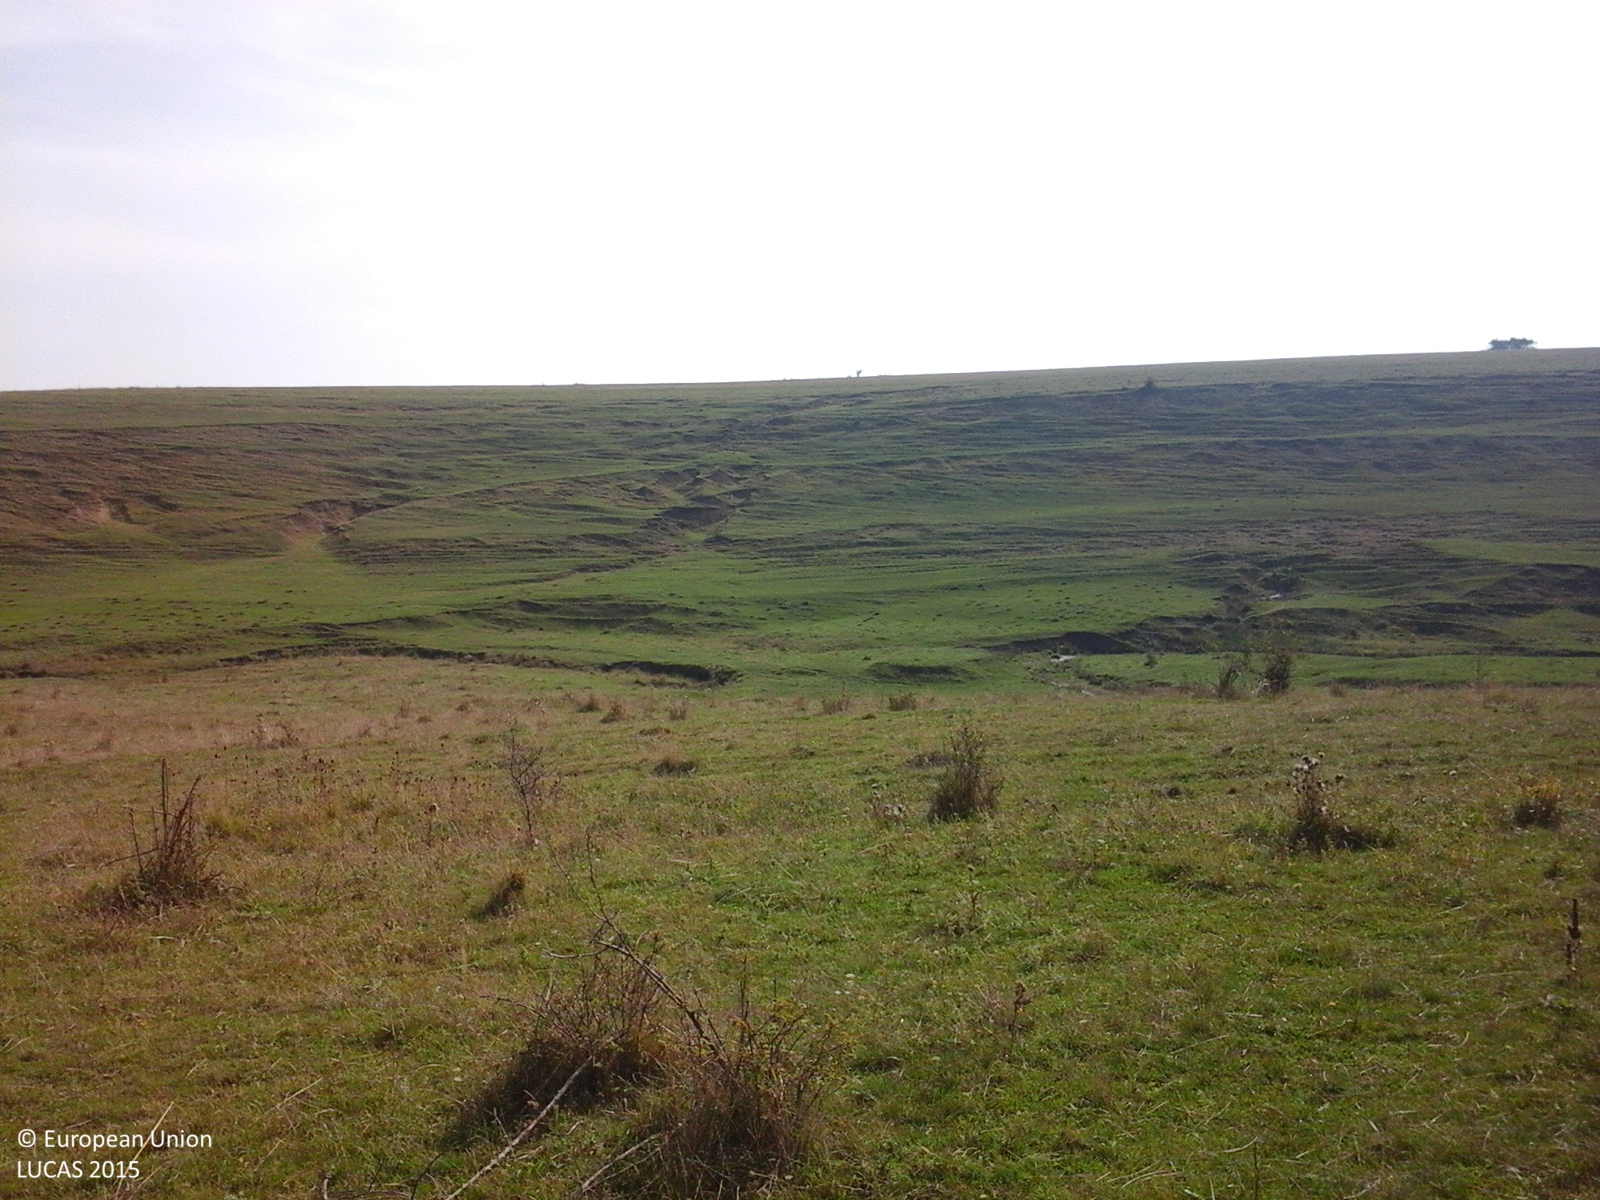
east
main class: Grassland
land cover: Grassland with sparse tree/shrub cover
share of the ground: > 75 %
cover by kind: herbaceous plants 90 %, broadleaved forest trees 5 %, shrubs 5 %
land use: Agriculture (excluding fallow land and kitchen gardens)
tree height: < 5 m
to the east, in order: Grassland with sparse tree/shrub cover; Grassland without tree/shrub cover; Rivers and streams; Grassland without tree/shrub cover
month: September
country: RO
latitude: 46.8155
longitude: 22.9702
